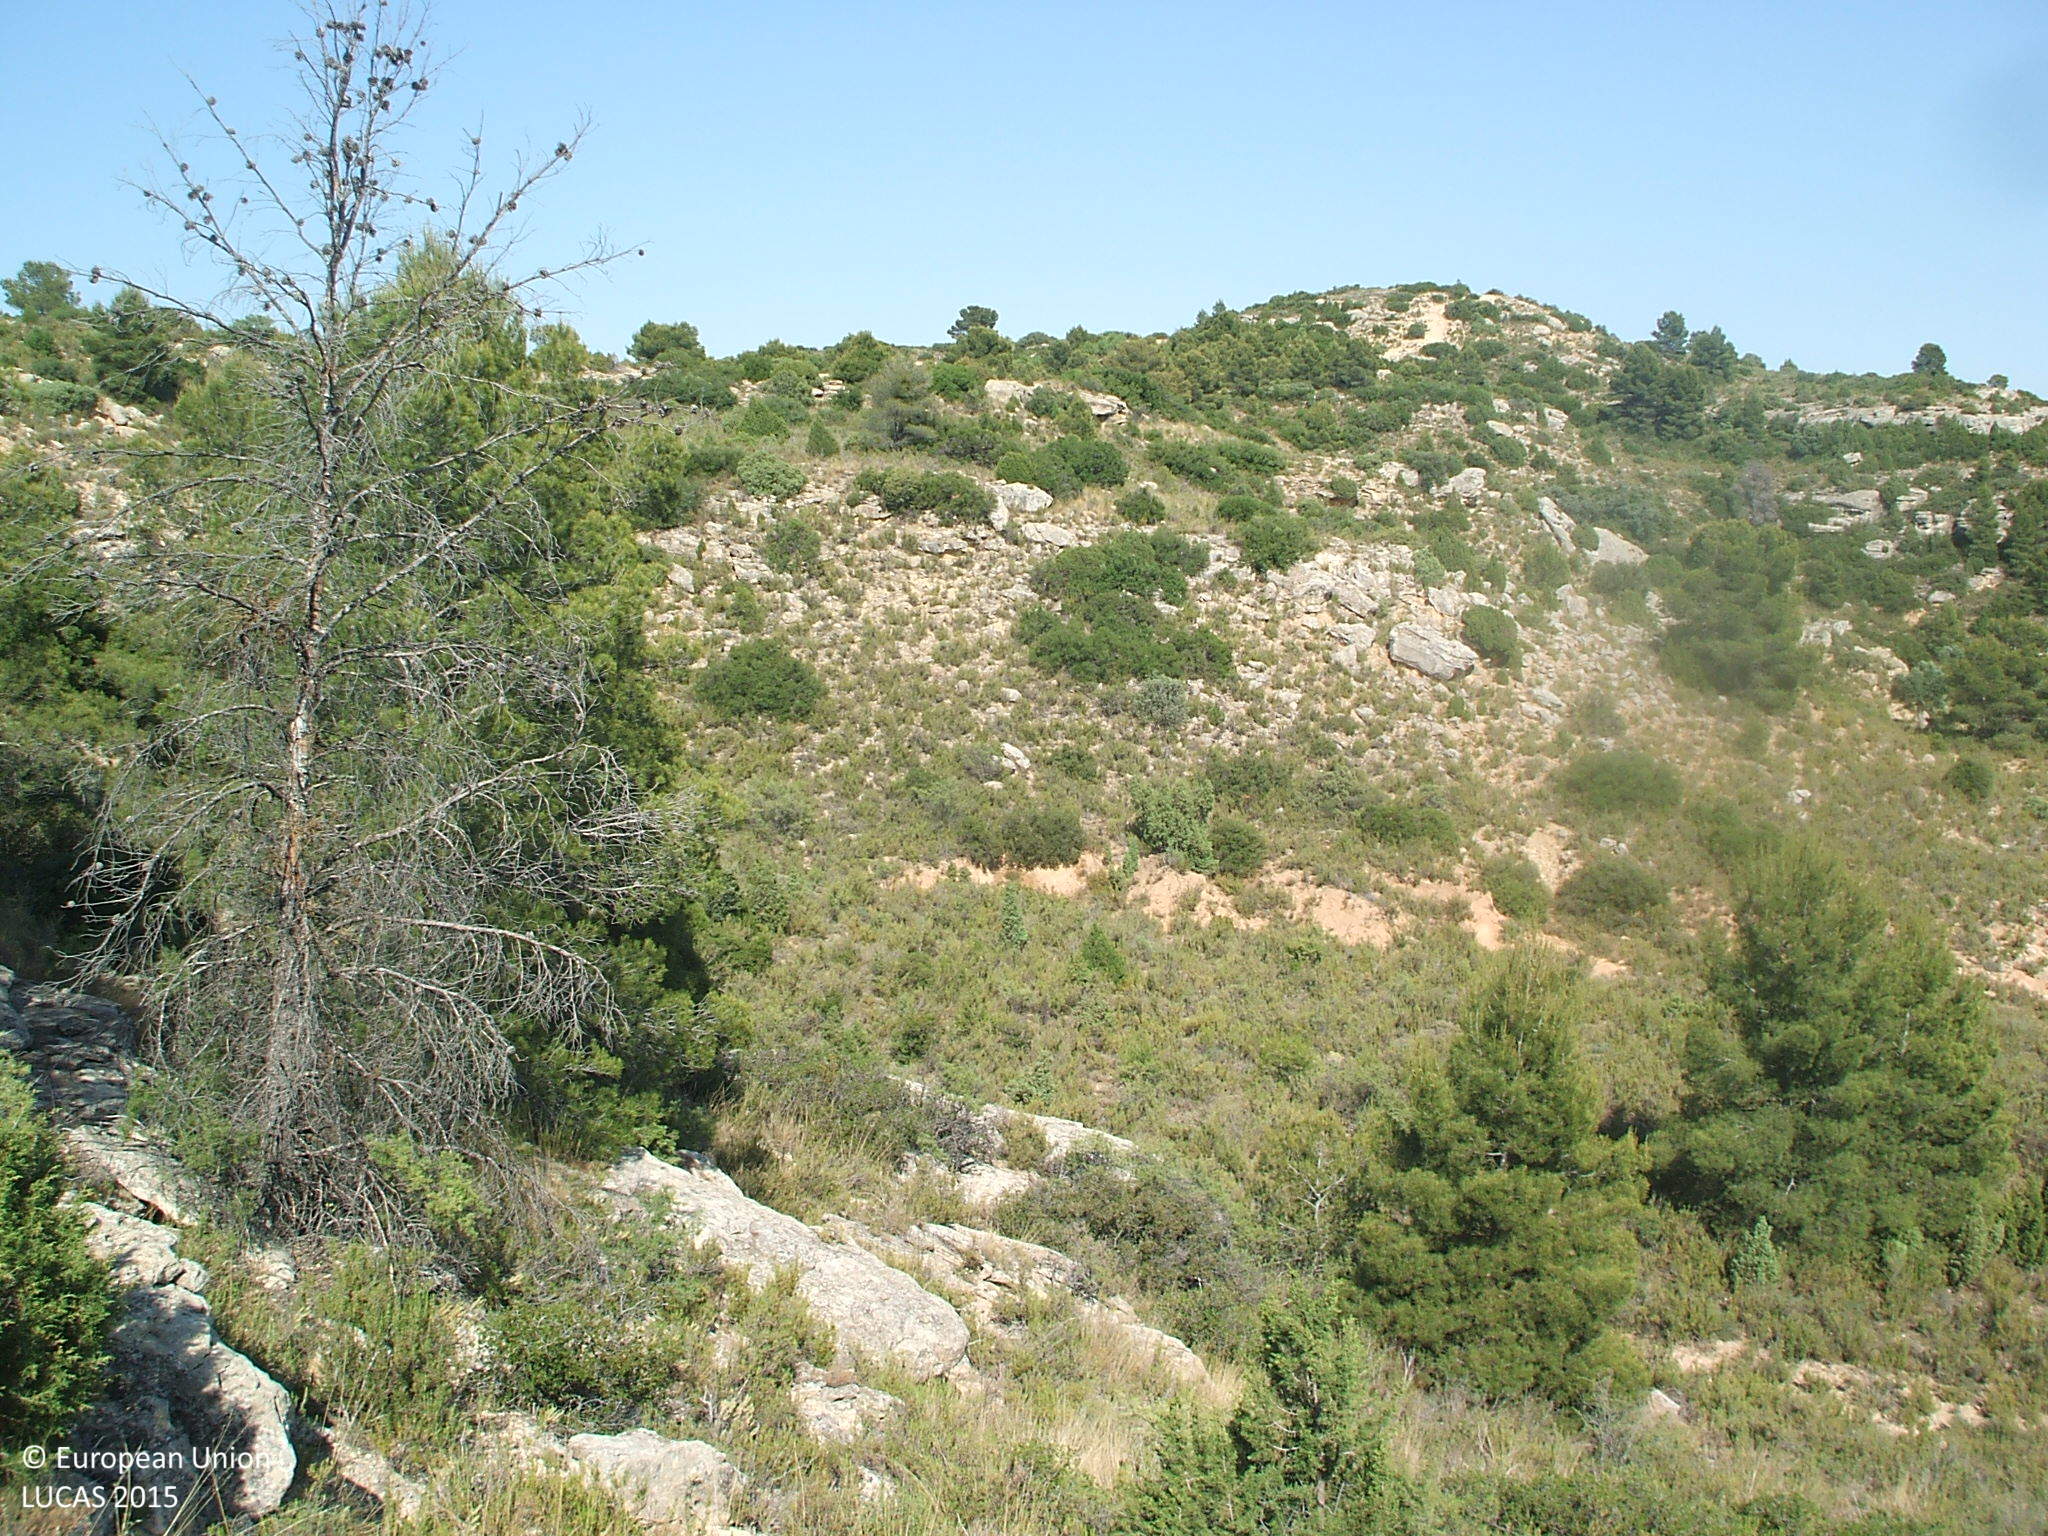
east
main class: Woodland
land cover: Pine dominated coniferous woodland
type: coniferous forest of the mediterranean region
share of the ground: 25 - 50 %
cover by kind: shrubs 60 %, coniferous forest trees 30 %, consolidated bare surface 10 %
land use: Semi-natural and natural areas not in use
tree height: > 5 m
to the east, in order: Pine dominated coniferous woodland; Rock outcrops; Pine dominated coniferous woodland; Rock outcrops; Pine dominated coniferous woodland
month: June
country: ES
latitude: 40.9677
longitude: -0.0750
